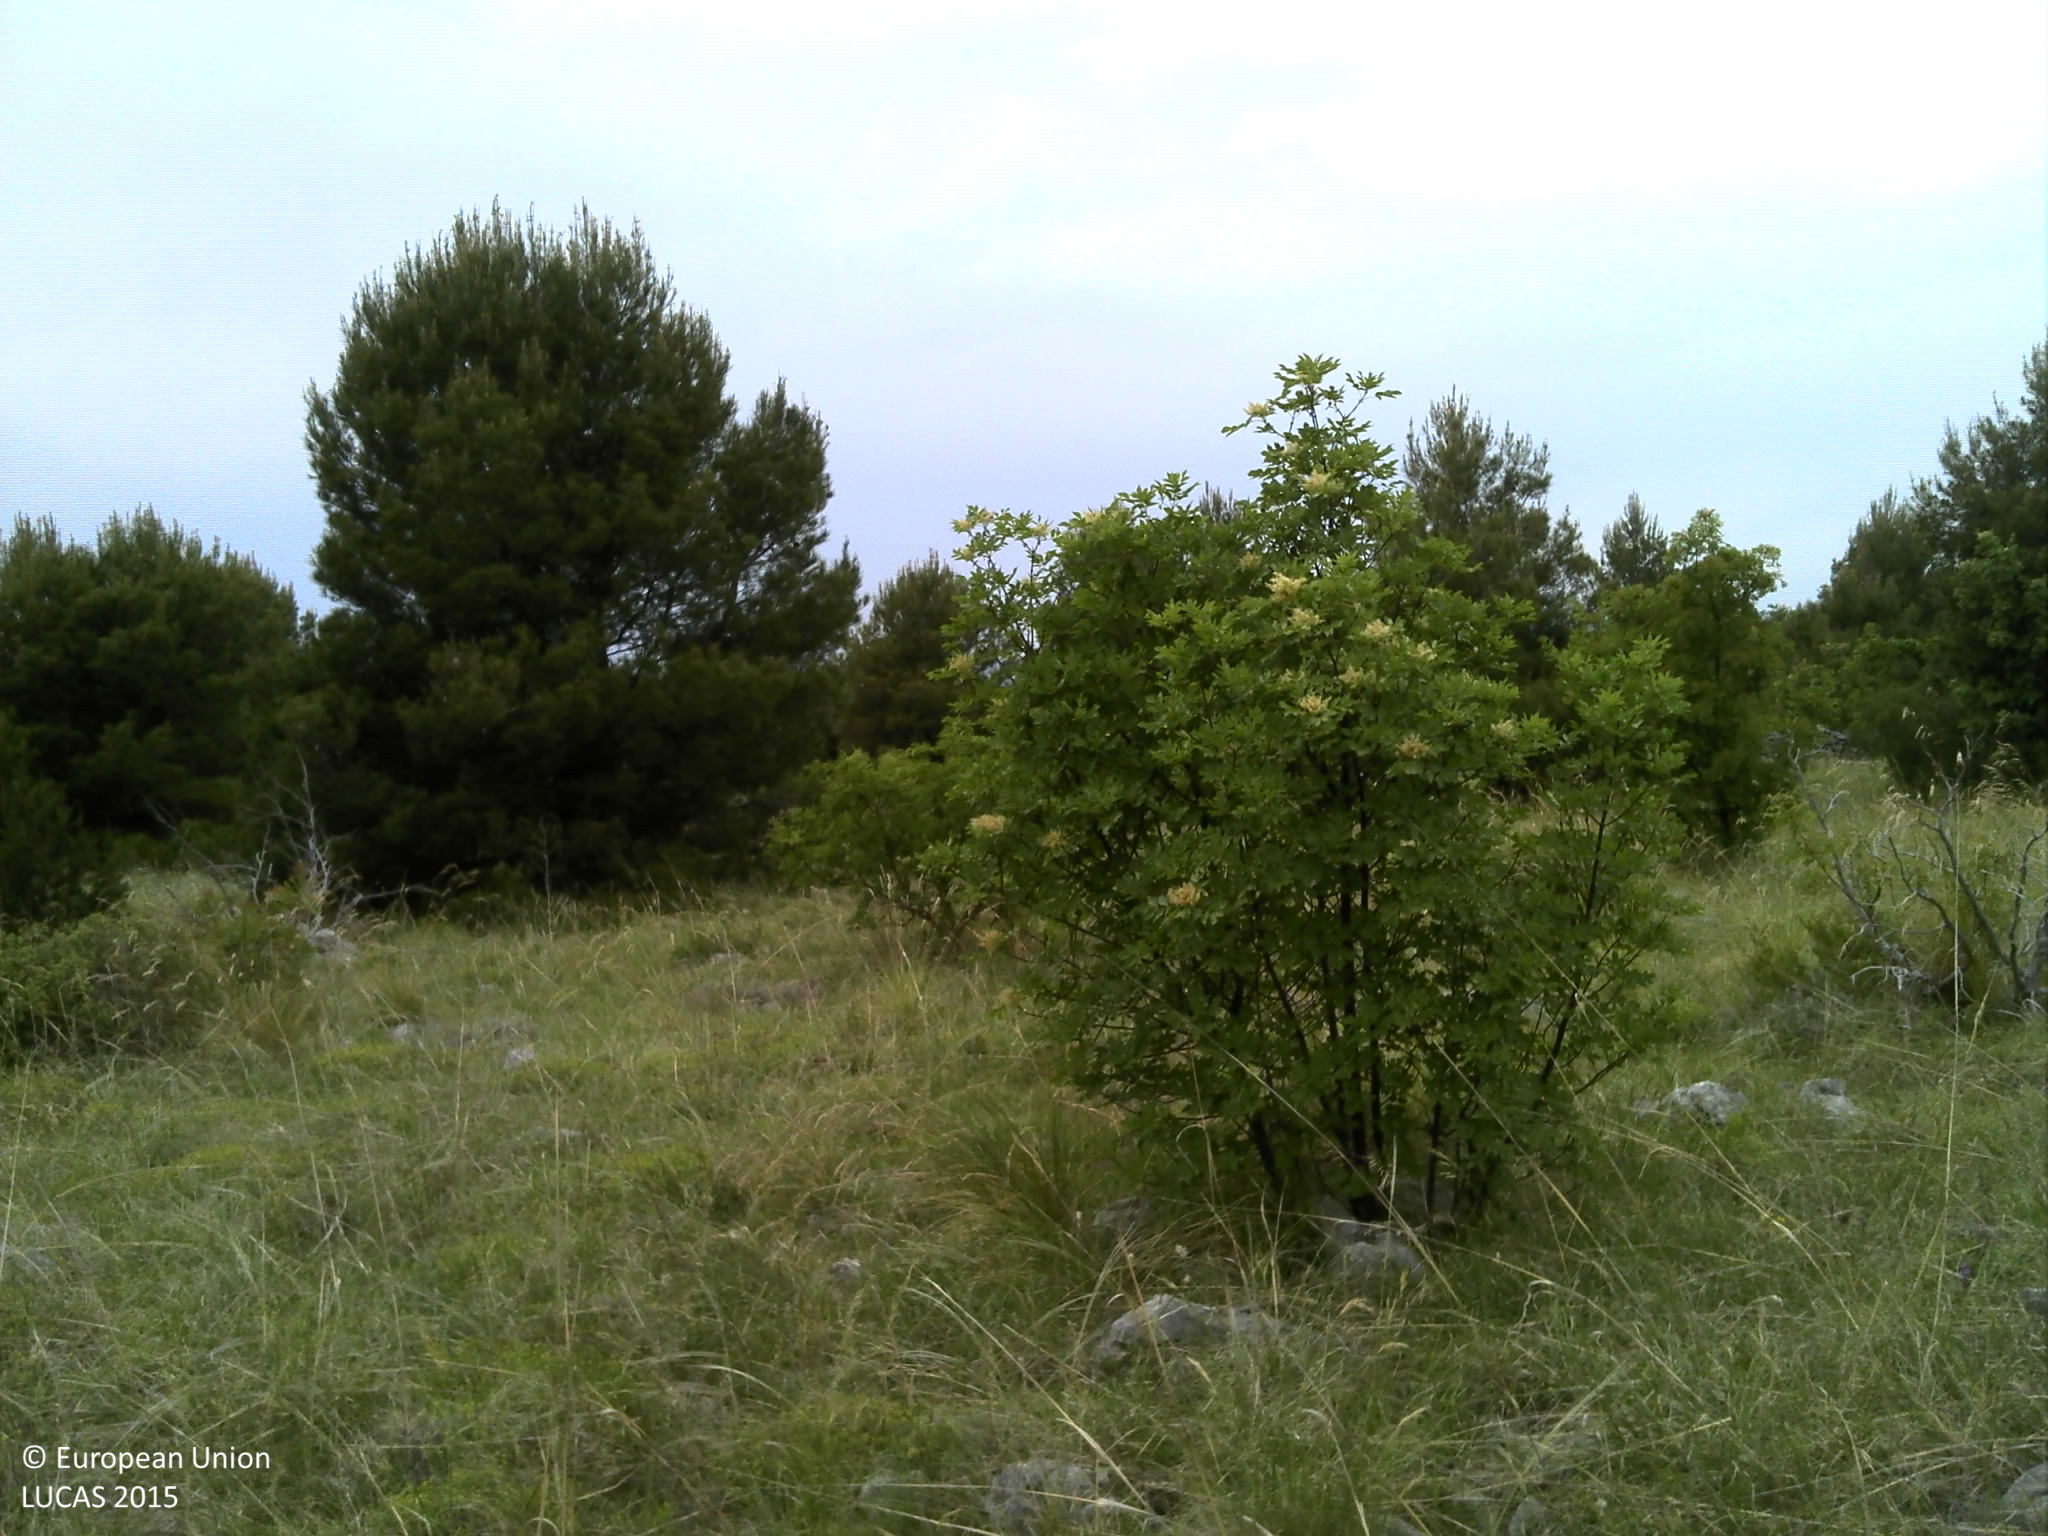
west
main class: Grassland
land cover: Grassland with sparse tree/shrub cover
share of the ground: > 75 %
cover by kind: herbaceous plants 70 %, shrubs 10 %, unconsolidated bare surface 10 %, coniferous forest trees 5 %, consolidated bare surface 5 %
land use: Abandoned areas
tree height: > 5 m
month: May
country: HR
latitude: 43.8018
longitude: 15.9202
